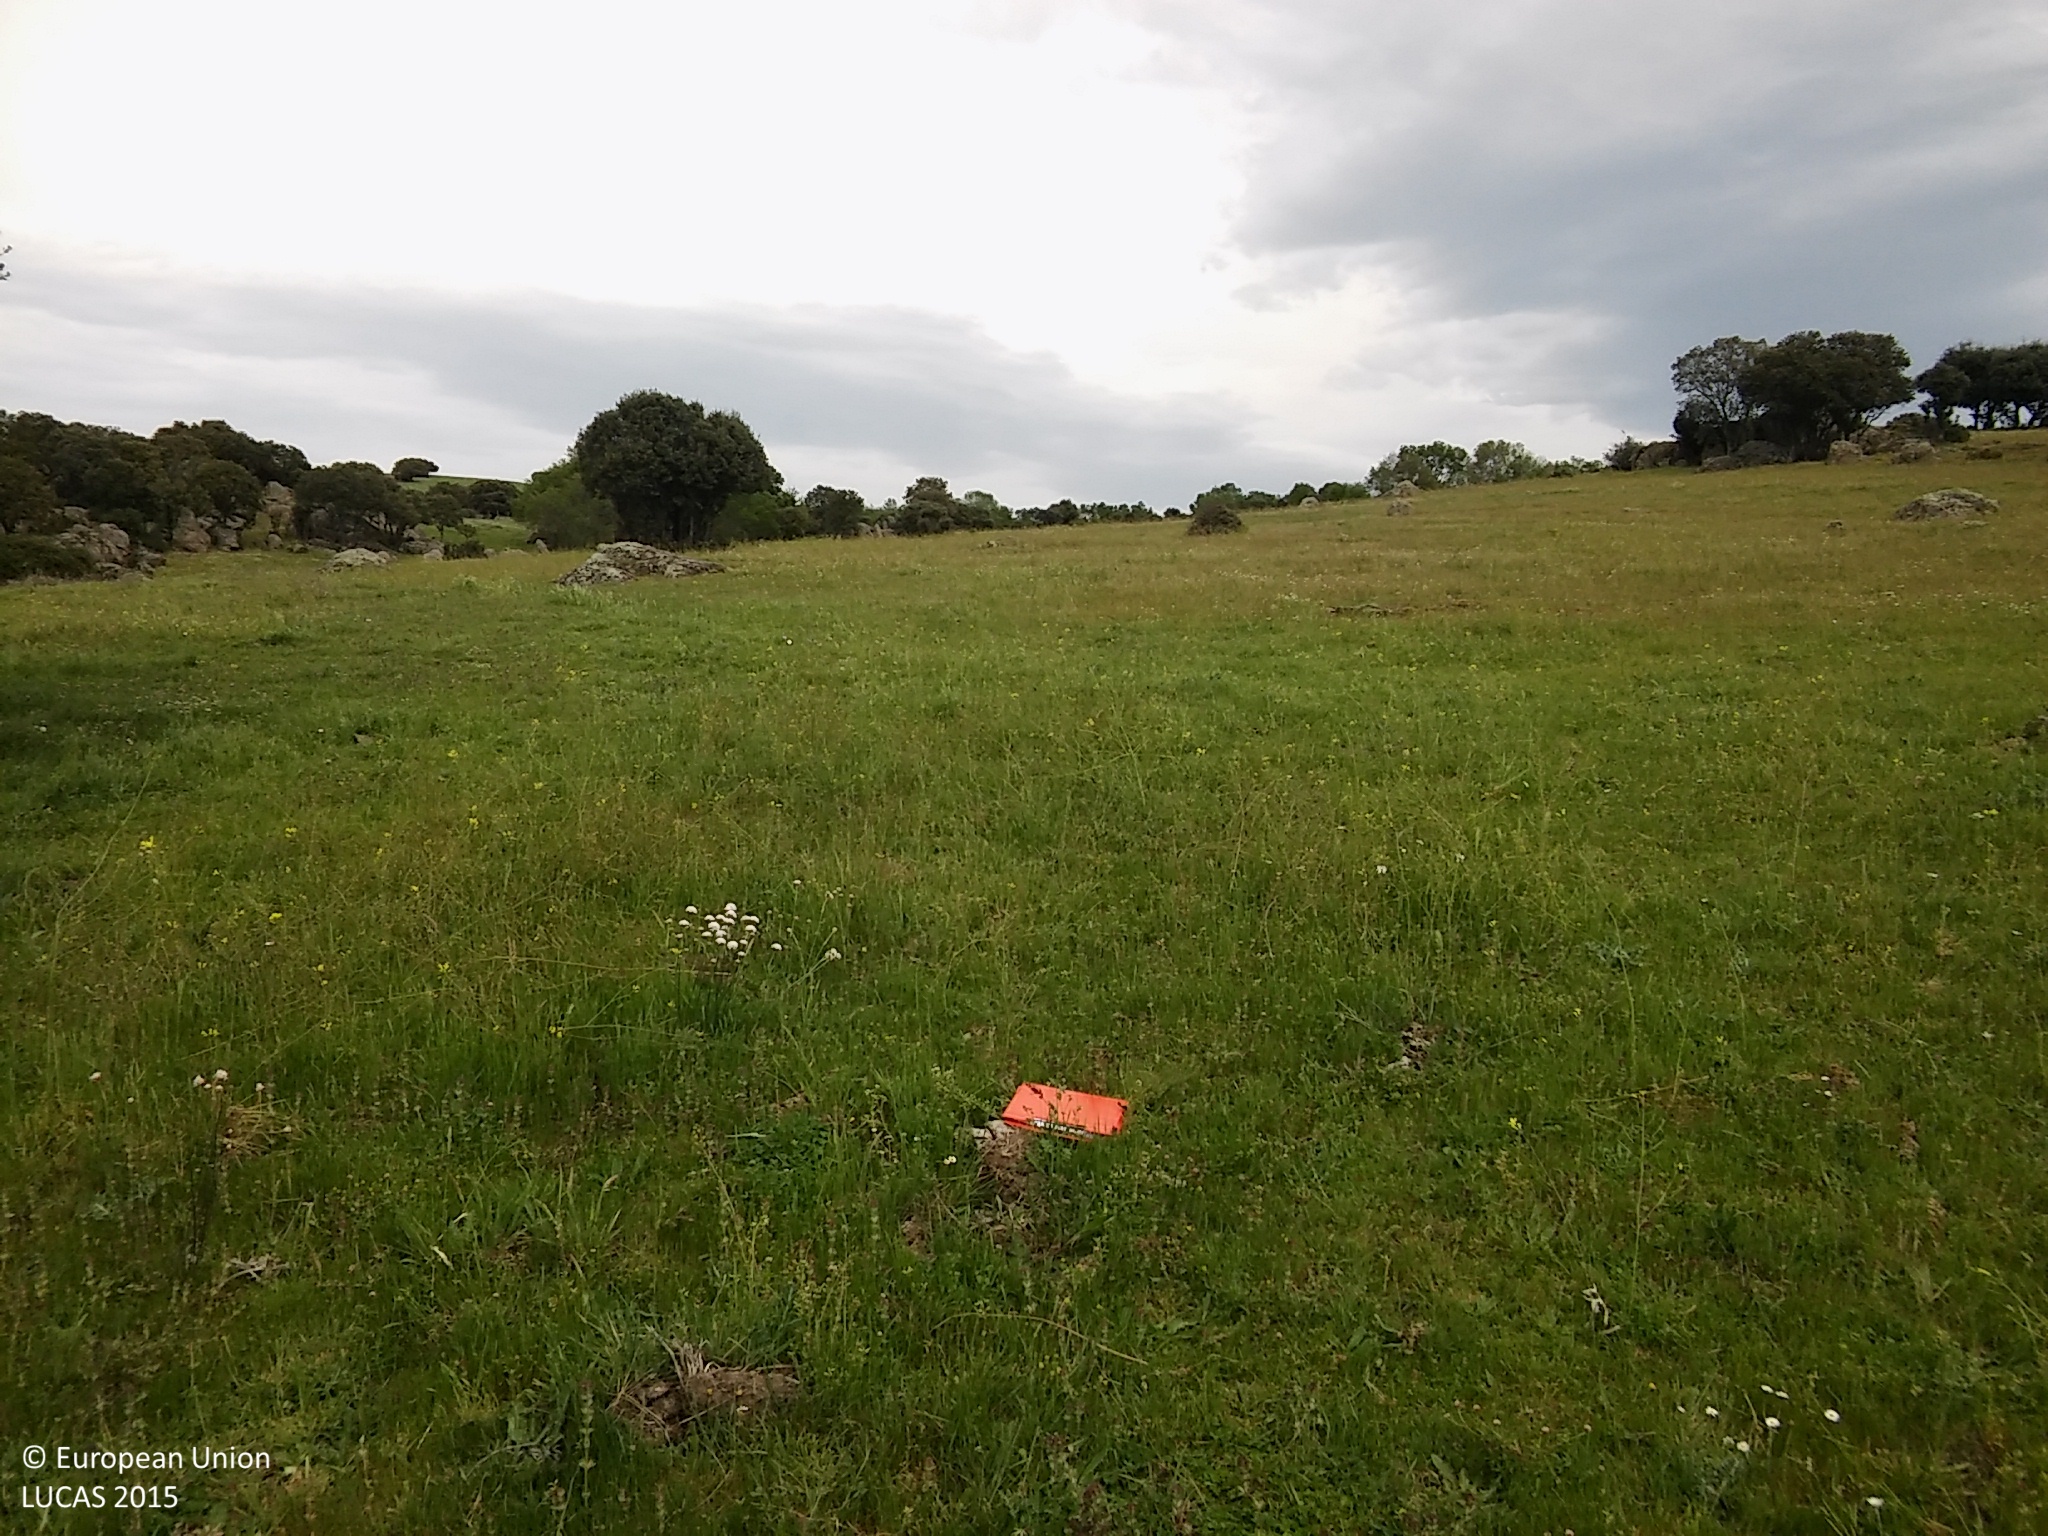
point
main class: Grassland
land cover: Grassland with sparse tree/shrub cover
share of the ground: > 75 %
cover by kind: herbaceous plants 90 %, broadleaved forest trees 5 %, shrubs 5 %
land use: Agriculture (excluding fallow land and kitchen gardens)
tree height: > 5 m
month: May
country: ES
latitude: 41.0673
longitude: -4.0337
